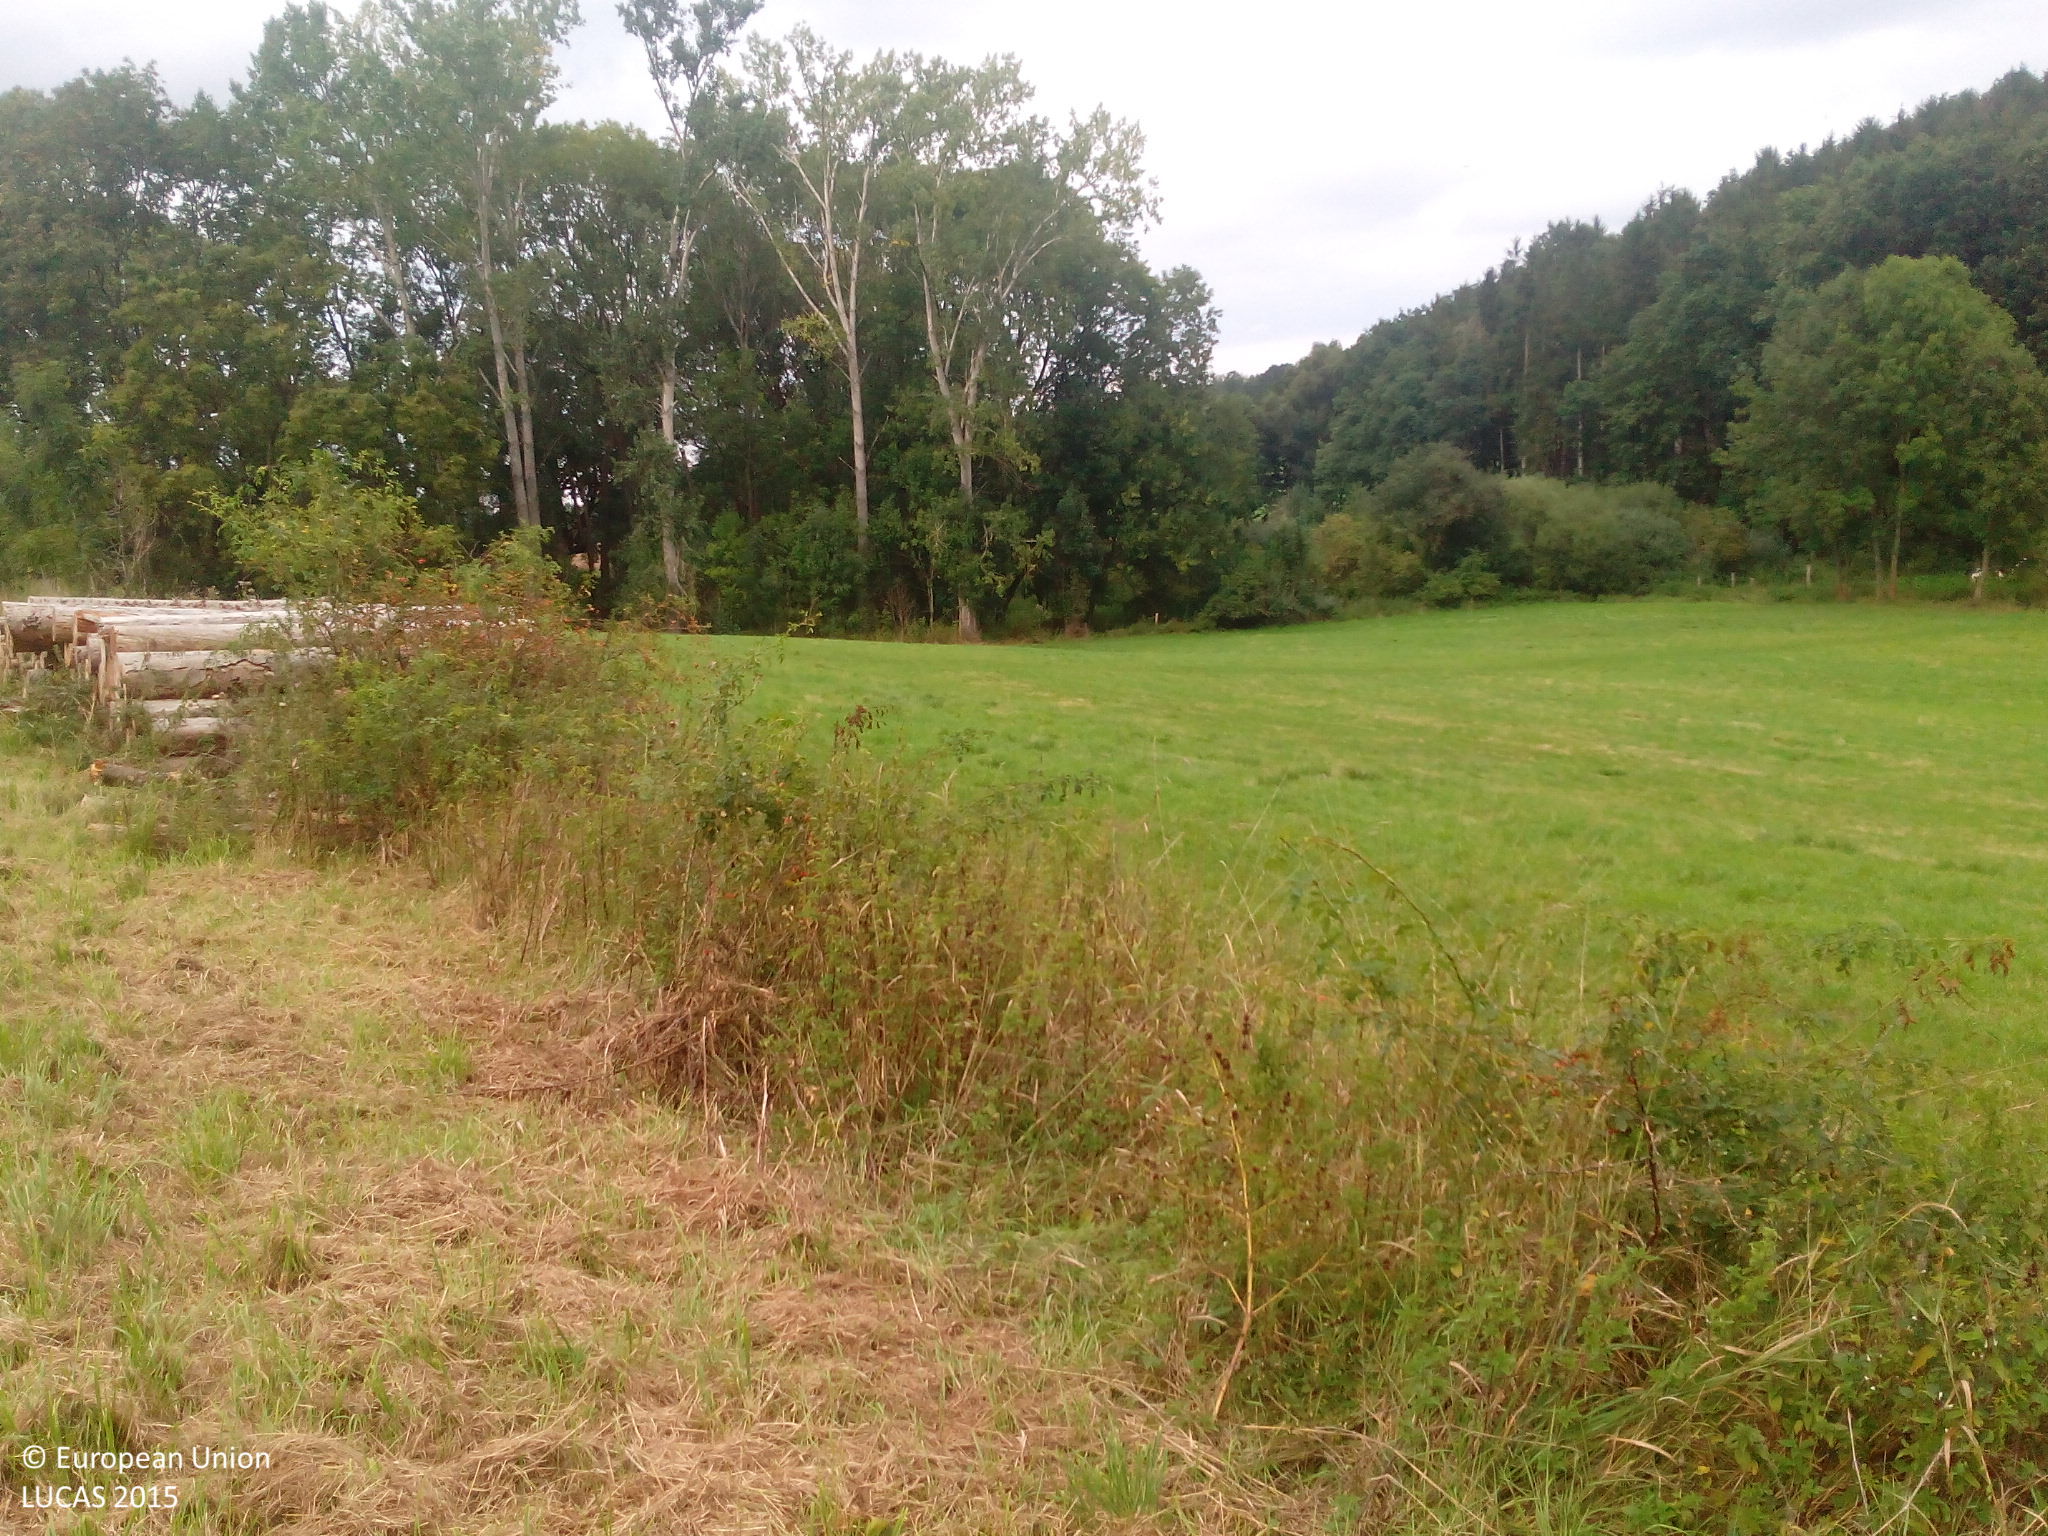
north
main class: Grassland
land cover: Grassland without tree/shrub cover
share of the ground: > 75 %
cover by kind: herbaceous plants 100 %
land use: Agriculture (excluding fallow land and kitchen gardens)
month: September
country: DE
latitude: 51.5490
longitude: 10.6199
